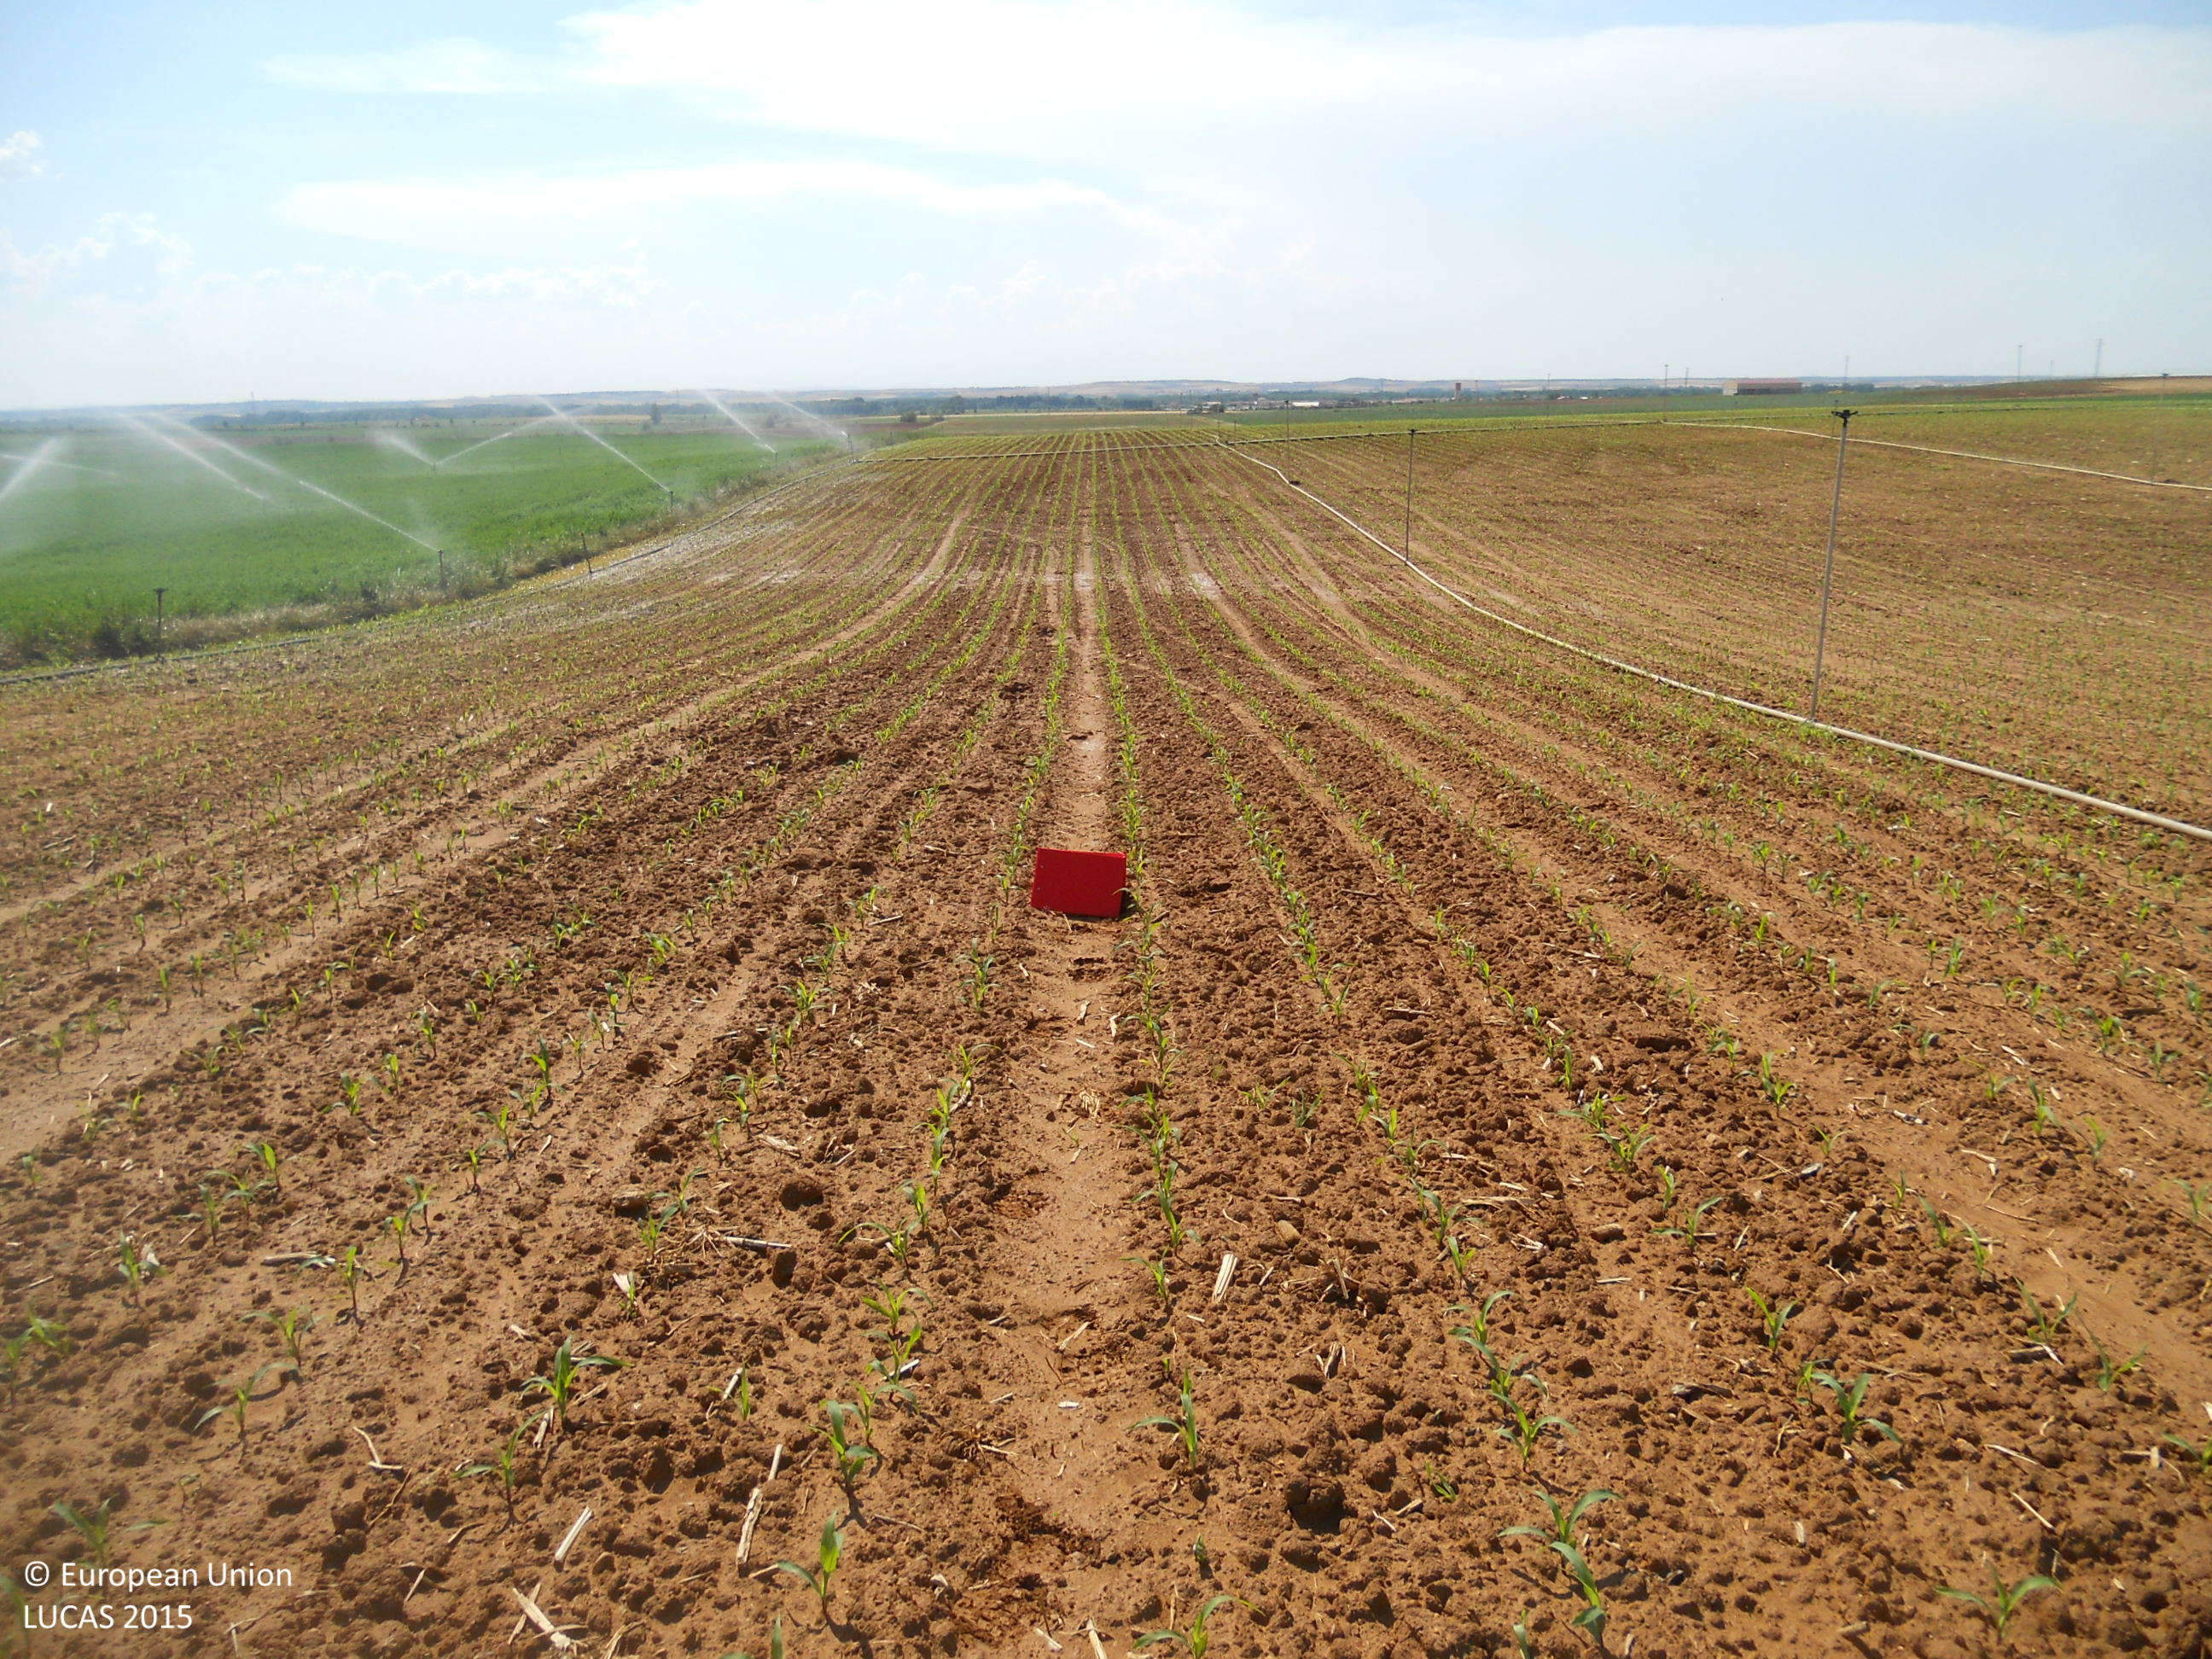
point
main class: Cropland
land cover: Maize
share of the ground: < 10 %
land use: Agriculture (excluding fallow land and kitchen gardens)
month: June
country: ES
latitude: 42.2036
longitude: -5.5088
